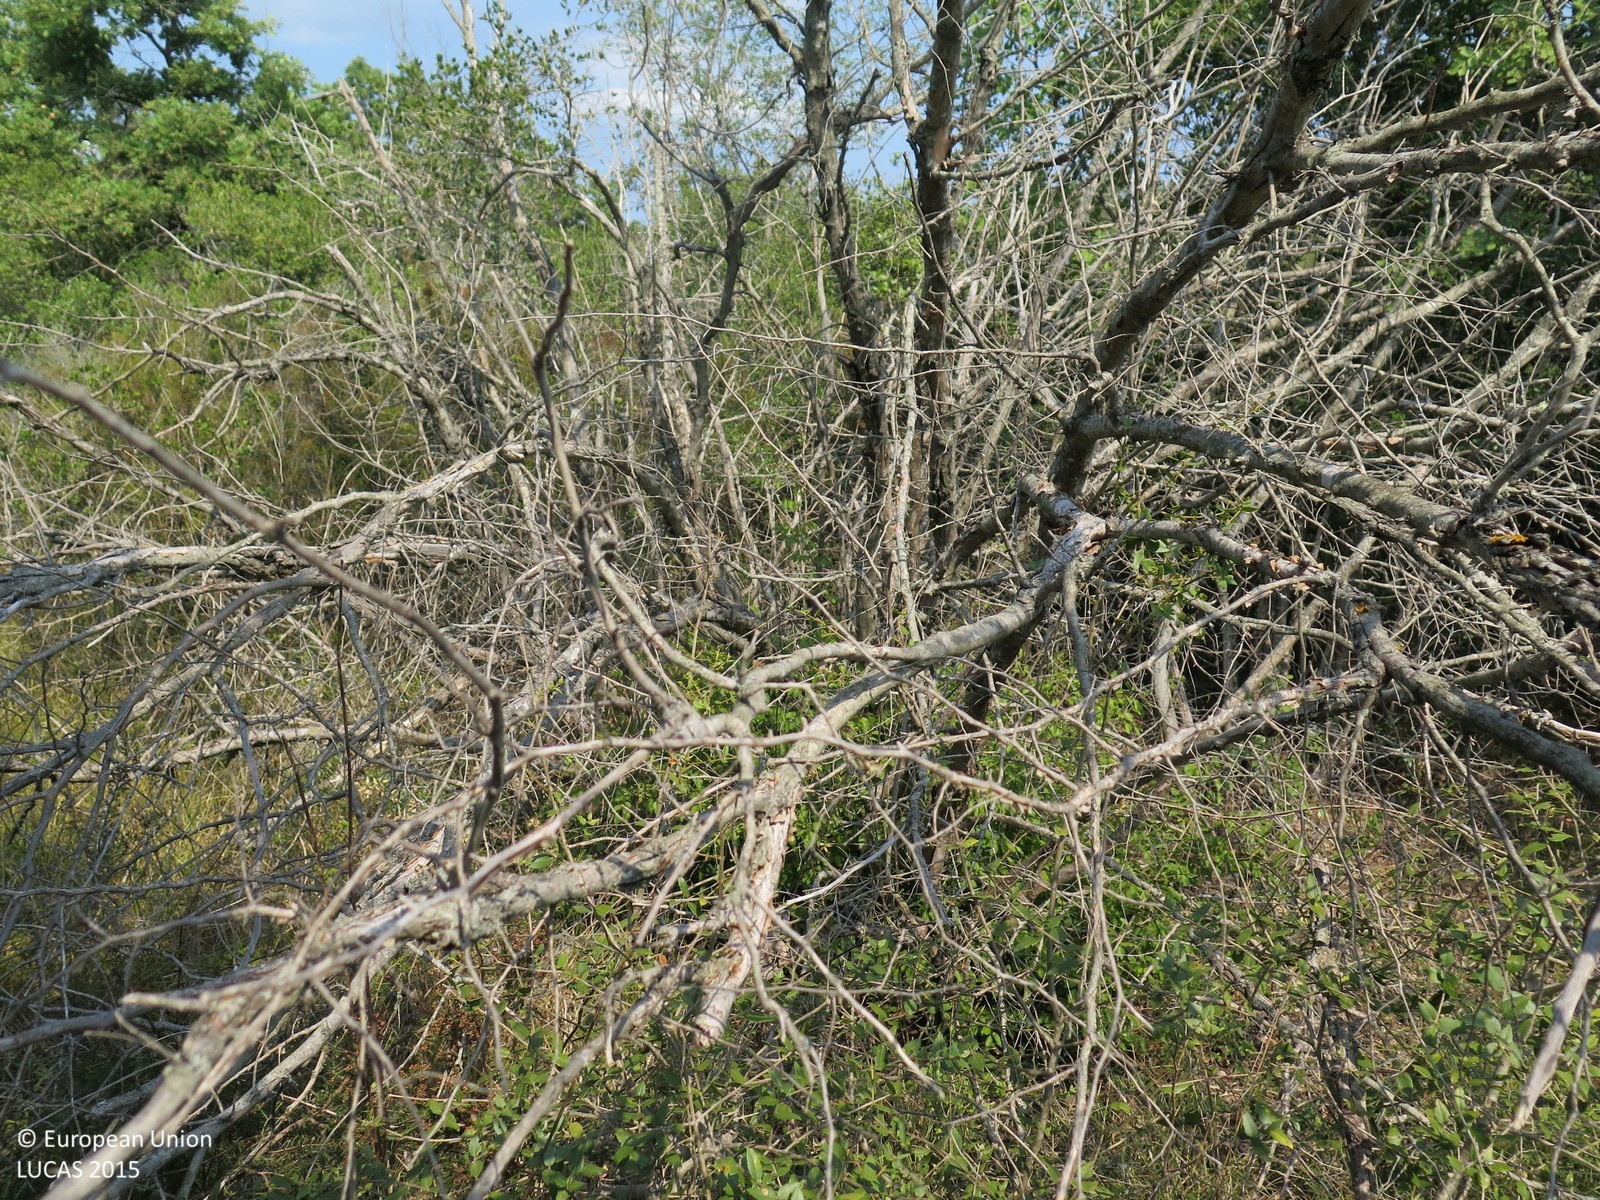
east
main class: Shrubland
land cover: Shrubland with sparse tree cover
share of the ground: > 75 %
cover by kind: shrubs 75 %, herbaceous plants 20 %, broadleaved forest trees 5 %
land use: Semi-natural and natural areas not in use
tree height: < 5 m
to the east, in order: Shrubland with sparse tree cover; Rocks and stones; Shrubland with sparse tree cover; Tracks; Shrubland with sparse tree cover; Tracks; Shrubland with sparse tree cover; Broadleaved woodland
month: July
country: HR
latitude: 45.0044
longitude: 13.7624
